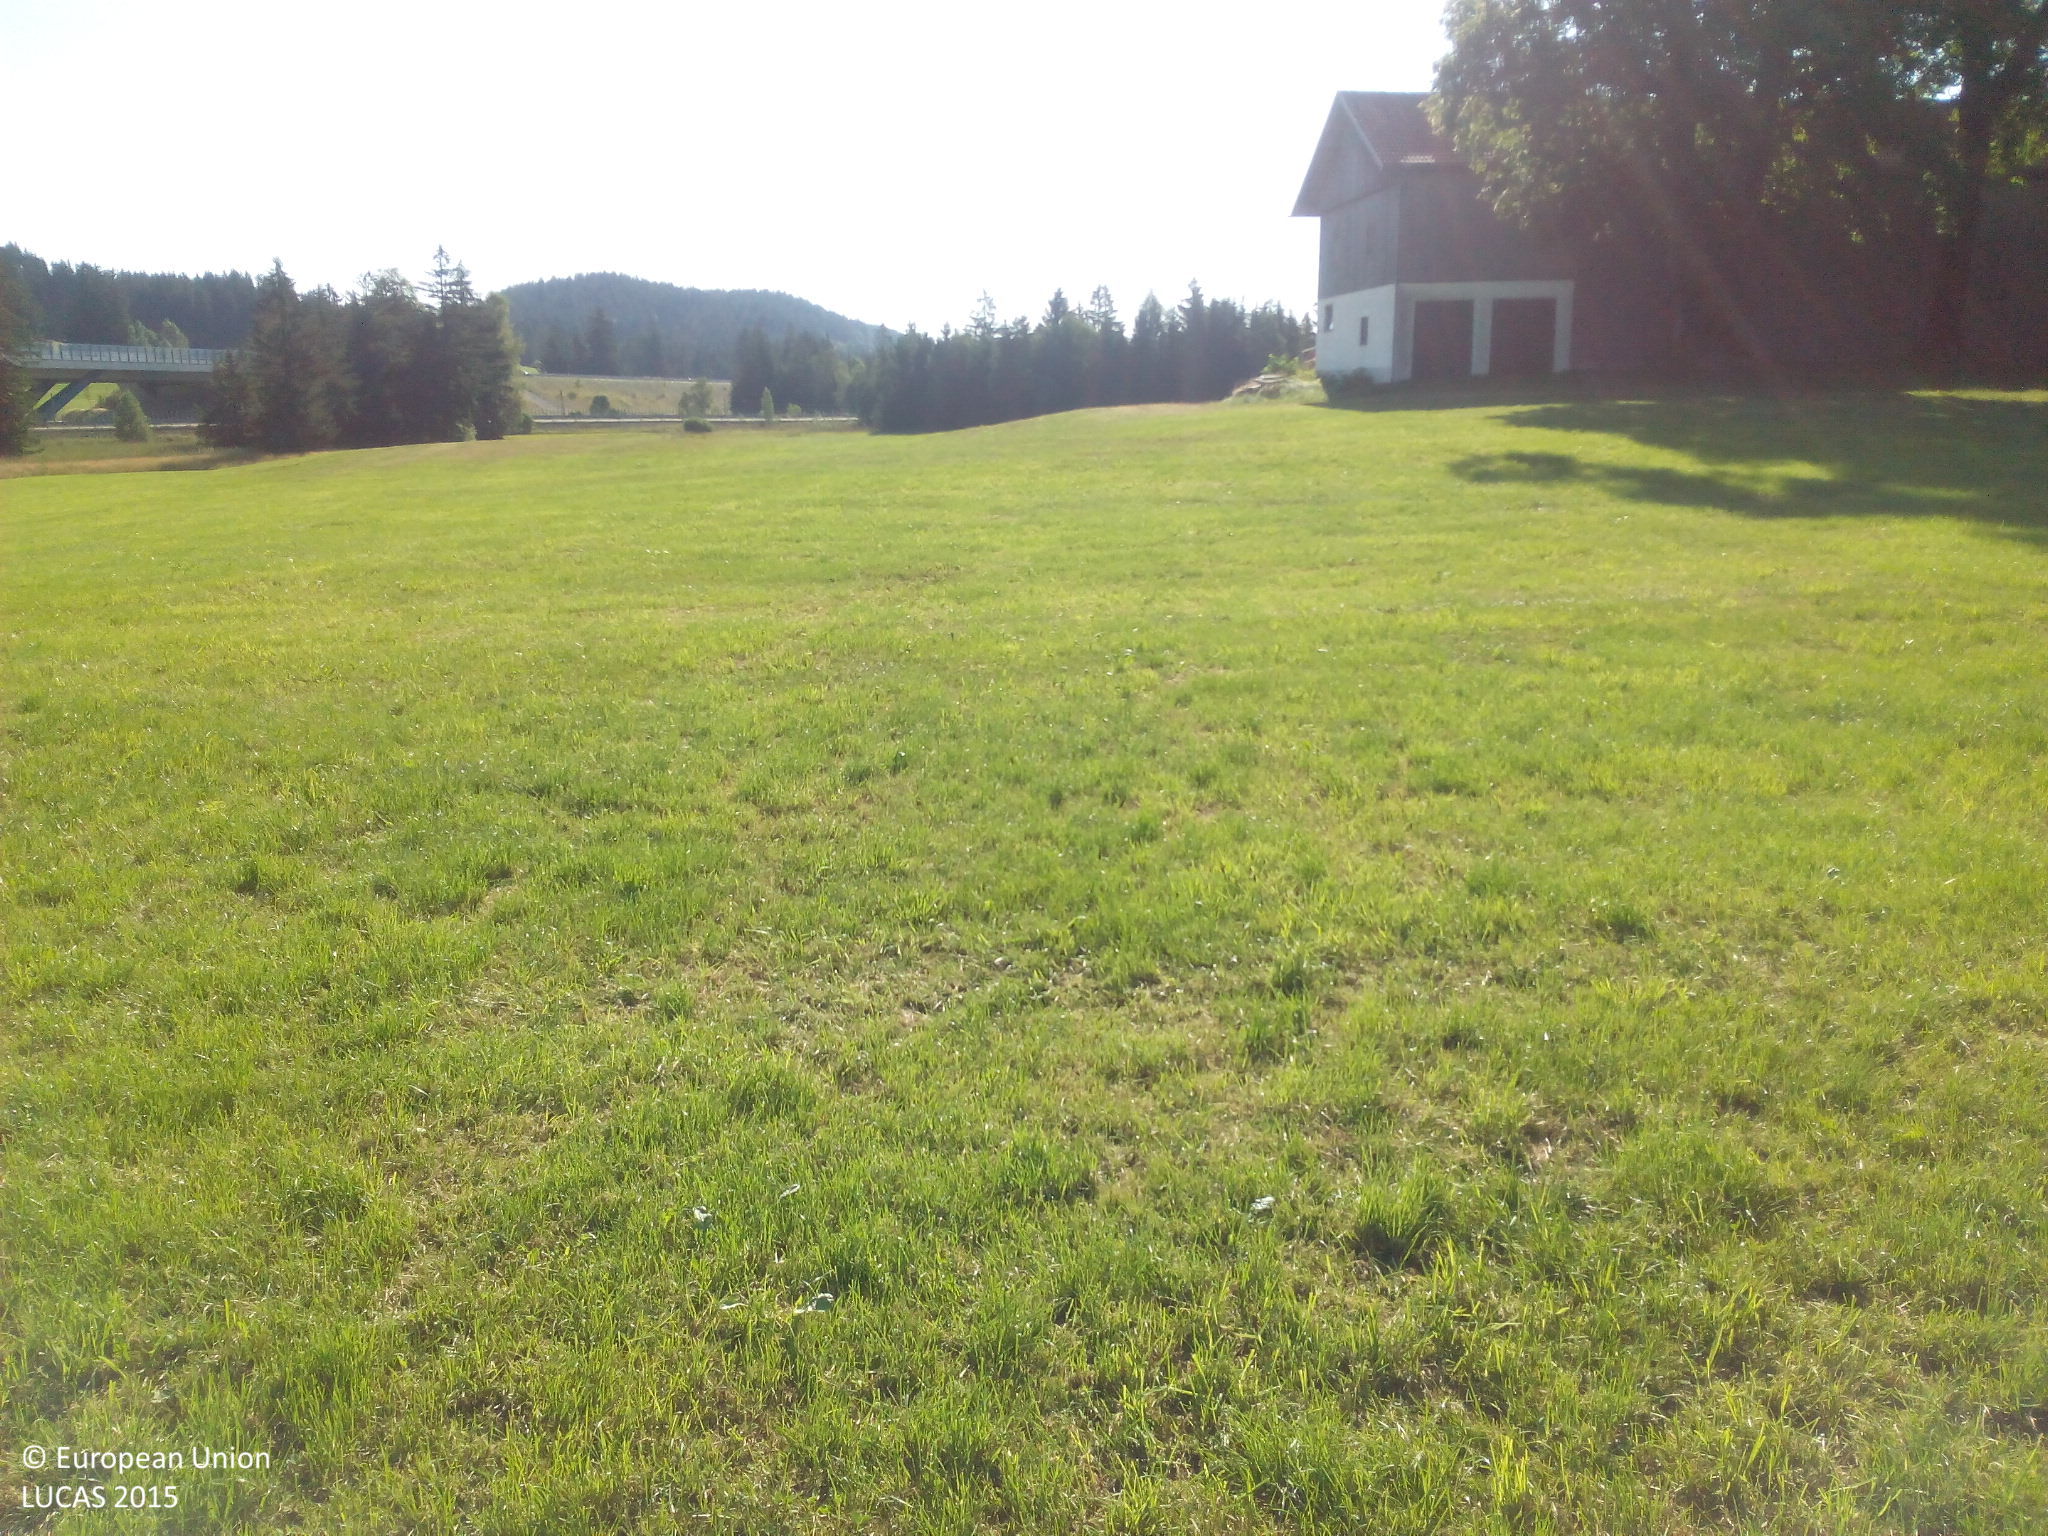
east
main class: Grassland
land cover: Grassland without tree/shrub cover
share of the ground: > 75 %
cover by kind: herbaceous plants 100 %
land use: Agriculture (excluding fallow land and kitchen gardens)
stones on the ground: < 10 %
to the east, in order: Grassland without tree/shrub cover; Rivers and streams; Grassland without tree/shrub cover; Spruce dominated coniferous woodland
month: July
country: DE
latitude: 47.6280
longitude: 10.5983
